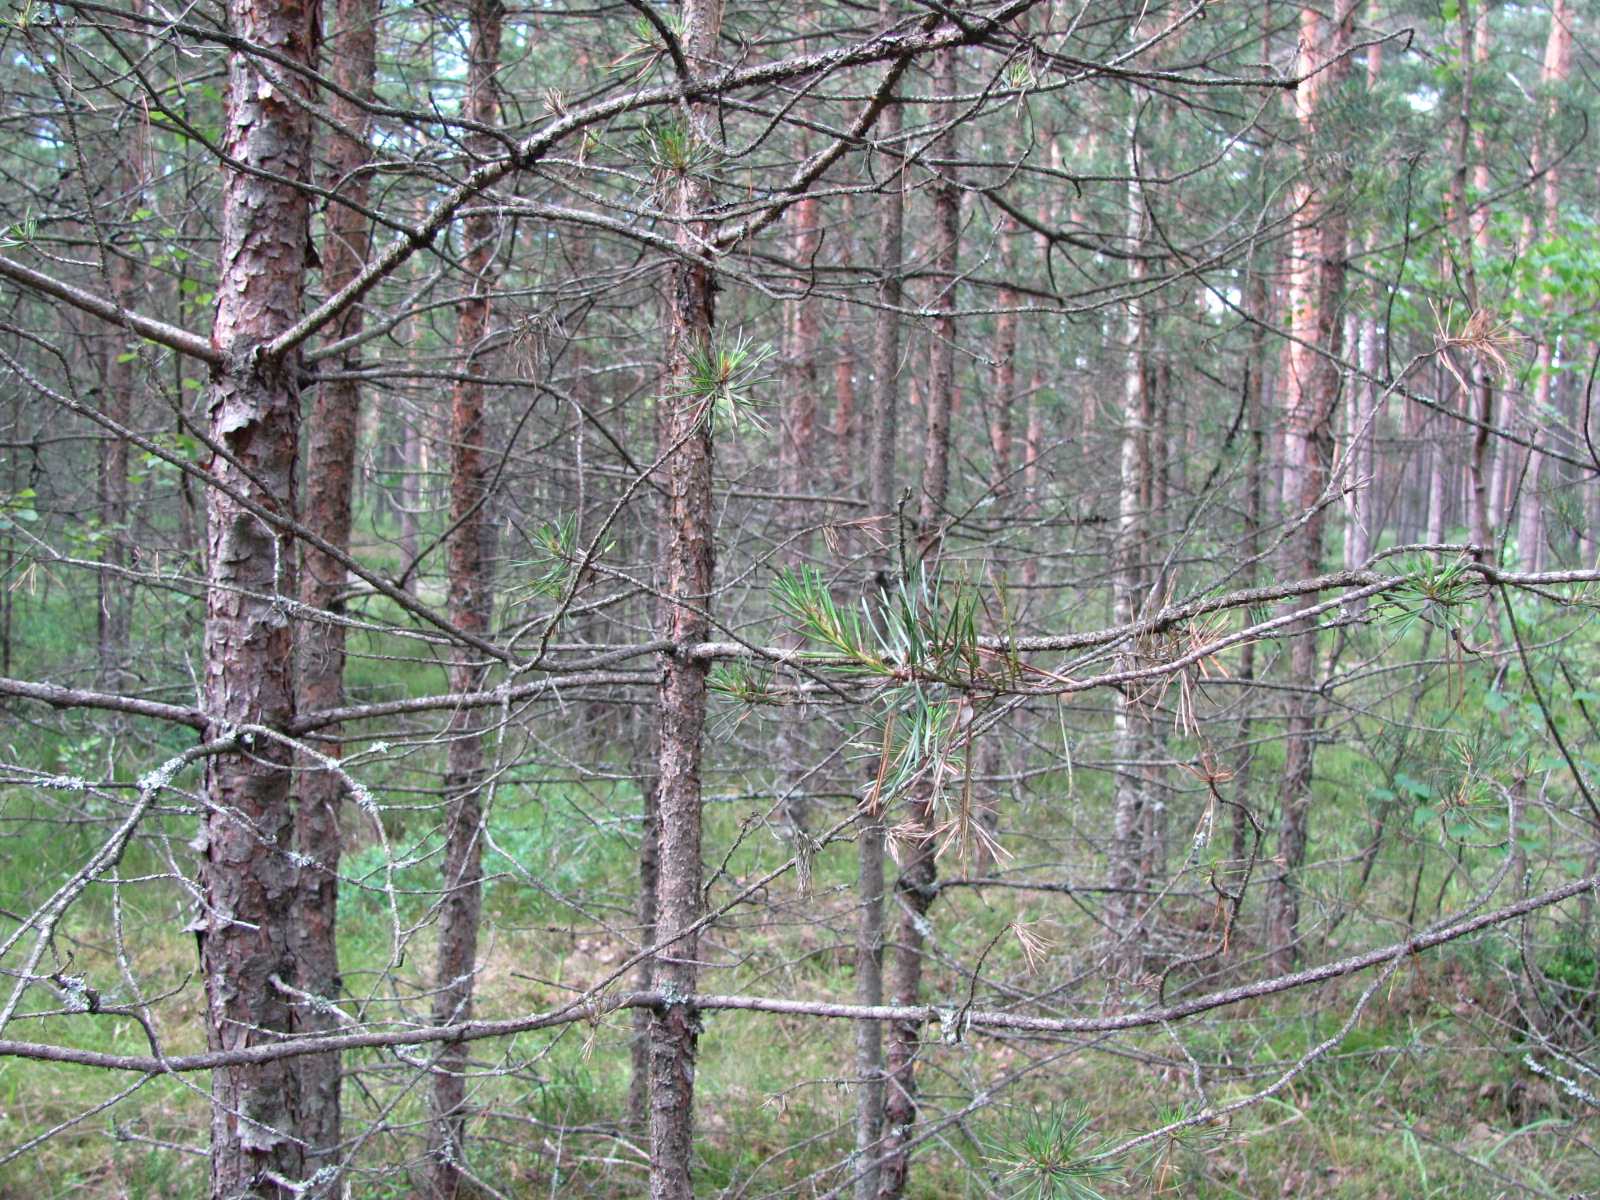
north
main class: Woodland
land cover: Pine dominated coniferous woodland
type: hemiboreal forest and nemoral coniferous forest and mixed broadleaved-coniferous forest
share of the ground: > 75 %
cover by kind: coniferous forest trees 80 %, herbaceous plants 10 %, broadleaved forest trees 5 %, lichens and mosses 5 %
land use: Forestry
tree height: > 5 m
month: June
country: LV
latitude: 57.0063
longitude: 23.9961
